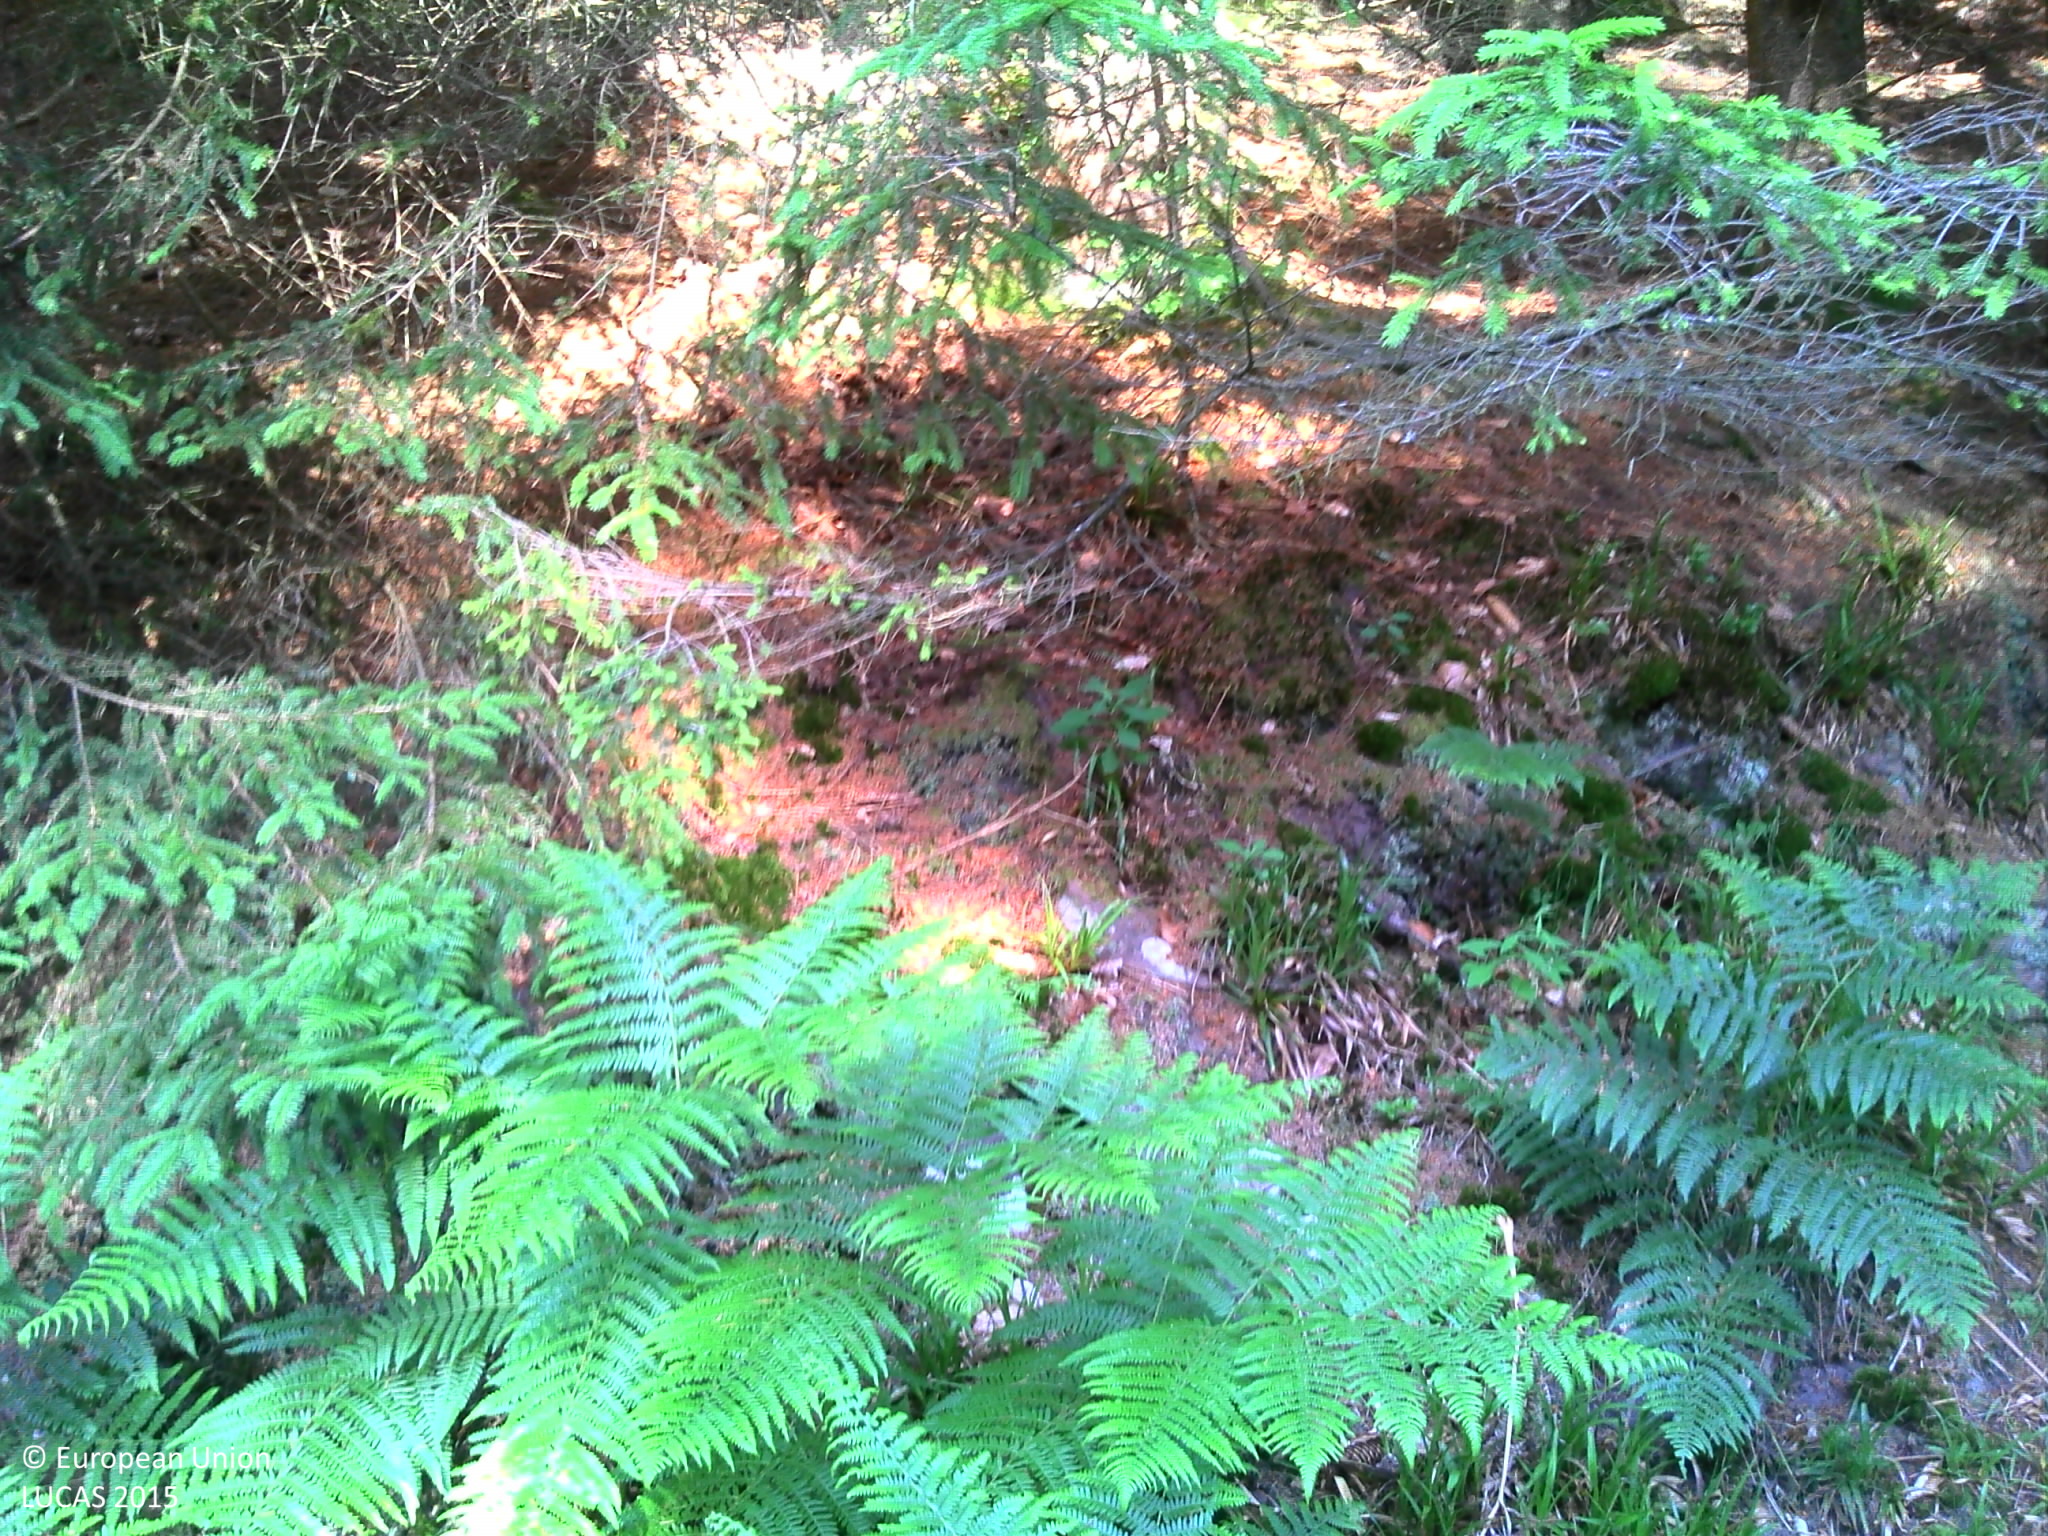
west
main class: Woodland
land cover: Spruce dominated coniferous woodland
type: alpine coniferous forest
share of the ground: > 75 %
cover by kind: coniferous forest trees 90 %, herbaceous plants 10 %
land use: Forestry
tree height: > 5 m
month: June
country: FR
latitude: 48.6759
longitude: 7.2710
